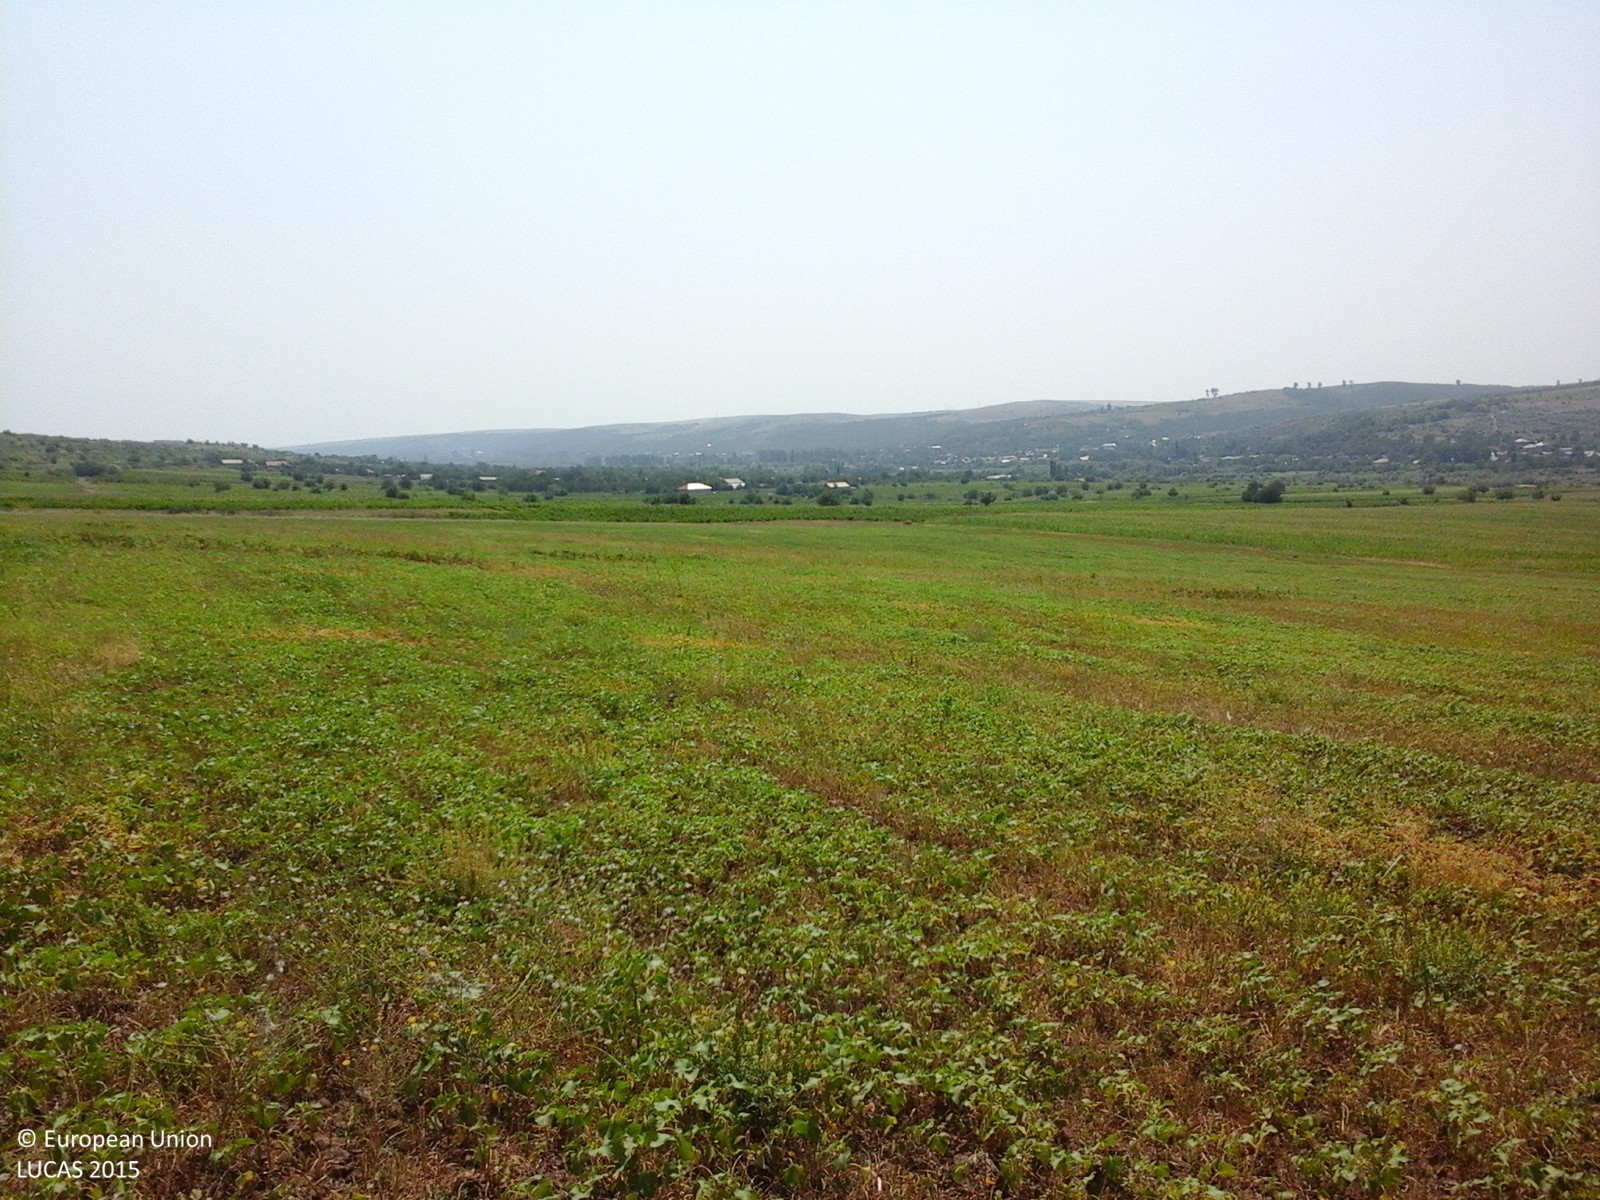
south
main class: Grassland
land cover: Spontaneously vegetated surfaces
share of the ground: > 75 %
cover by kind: herbaceous plants 100 %
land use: Agriculture (excluding fallow land and kitchen gardens)
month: July
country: RO
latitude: 45.8090
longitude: 27.9677
